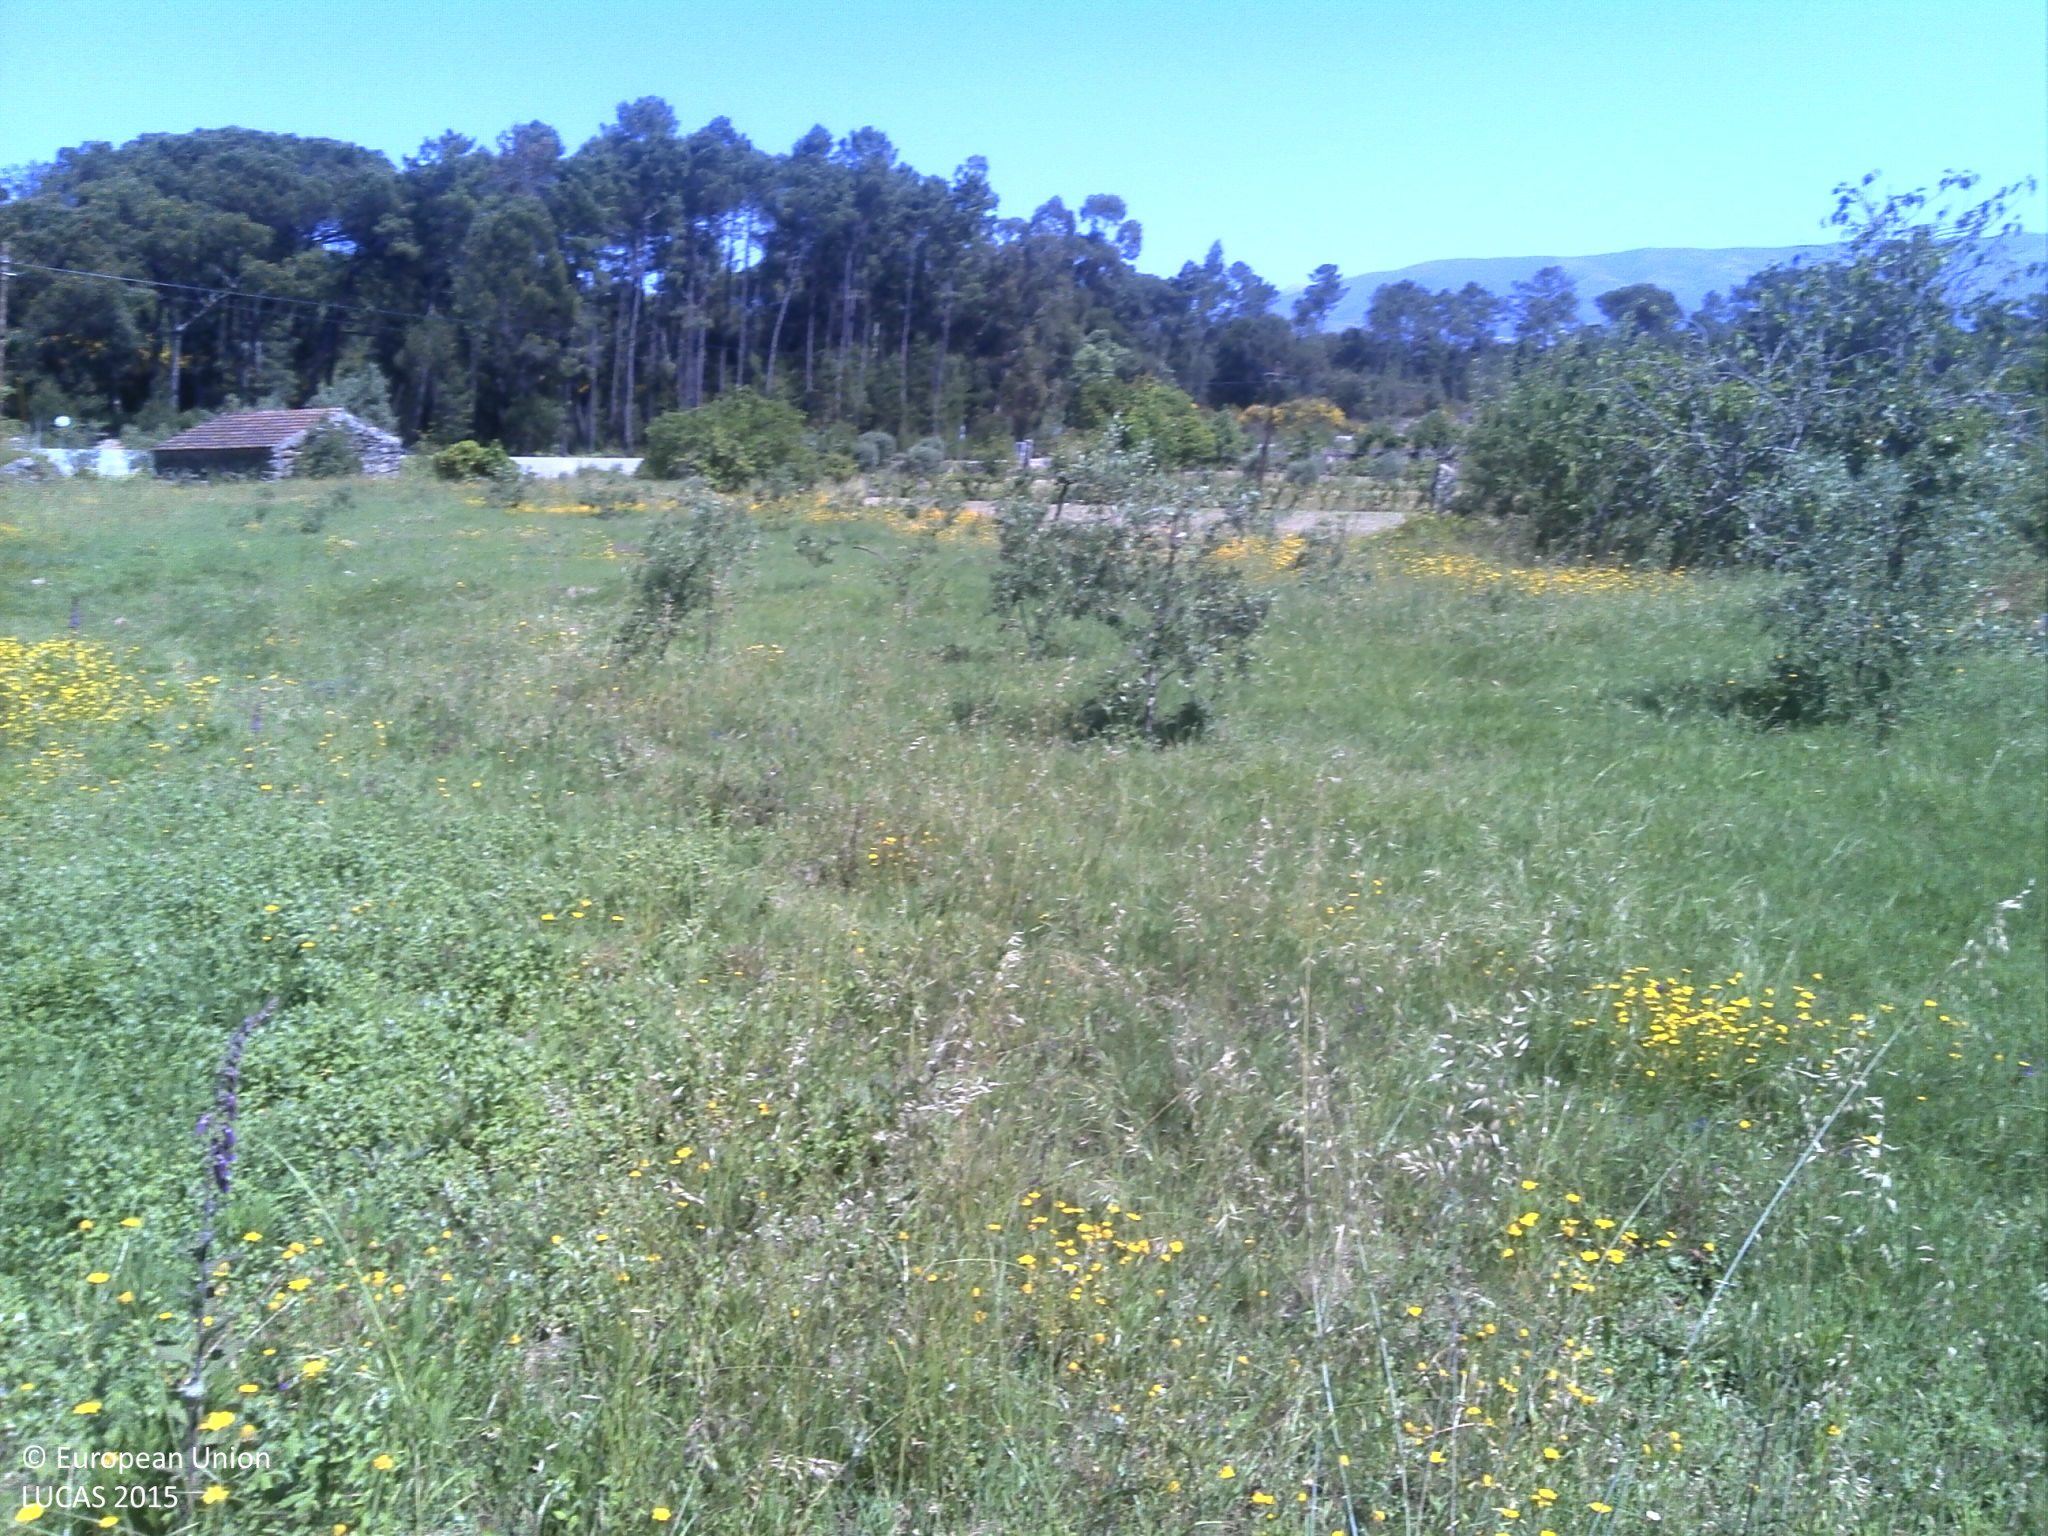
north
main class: Grassland
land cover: Grassland without tree/shrub cover
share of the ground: > 75 %
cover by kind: herbaceous plants 95 %, unconsolidated bare surface 5 %
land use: Agriculture (excluding fallow land and kitchen gardens)
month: May
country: PT
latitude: 40.5547
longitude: -7.7497
